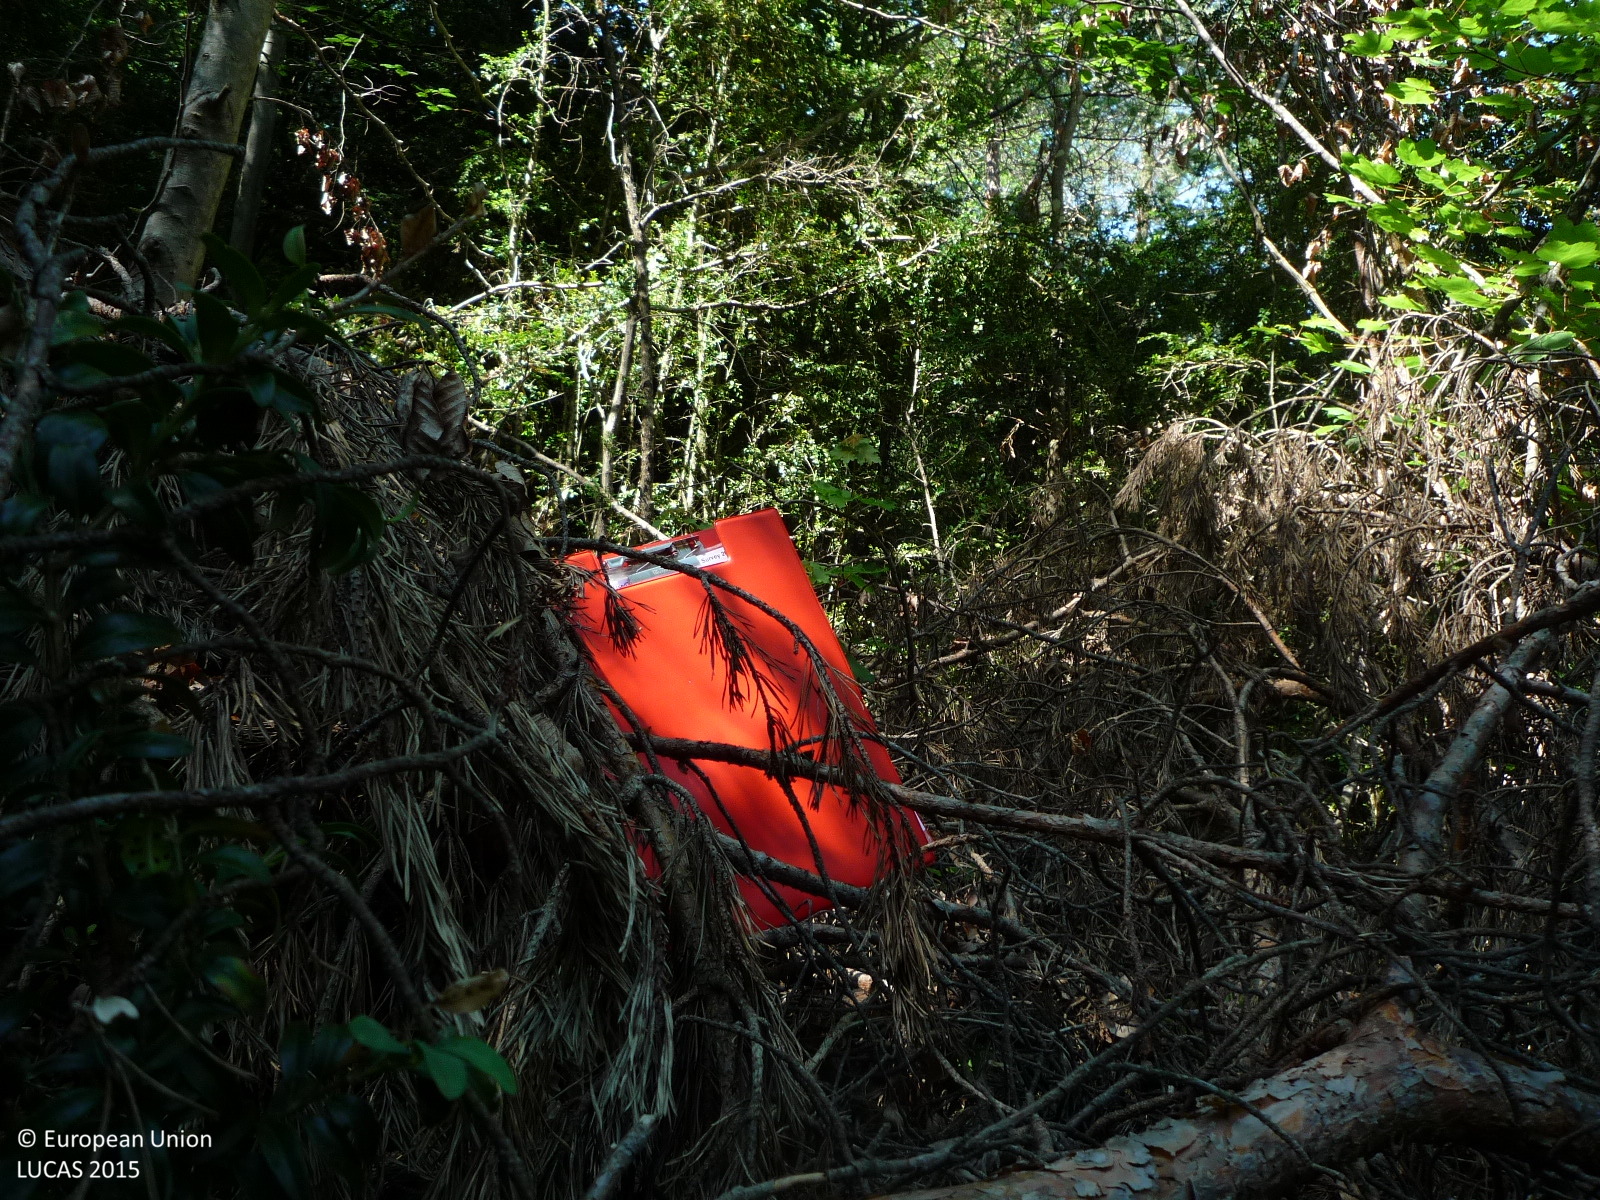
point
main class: Woodland
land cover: Pine dominated mixed woodland
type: coniferous forest of the mediterranean region
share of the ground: > 75 %
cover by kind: coniferous forest trees 55 %, broadleaved forest trees 45 %
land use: Forestry
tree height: > 5 m
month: June
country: ES
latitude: 42.1549
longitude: 1.9892
